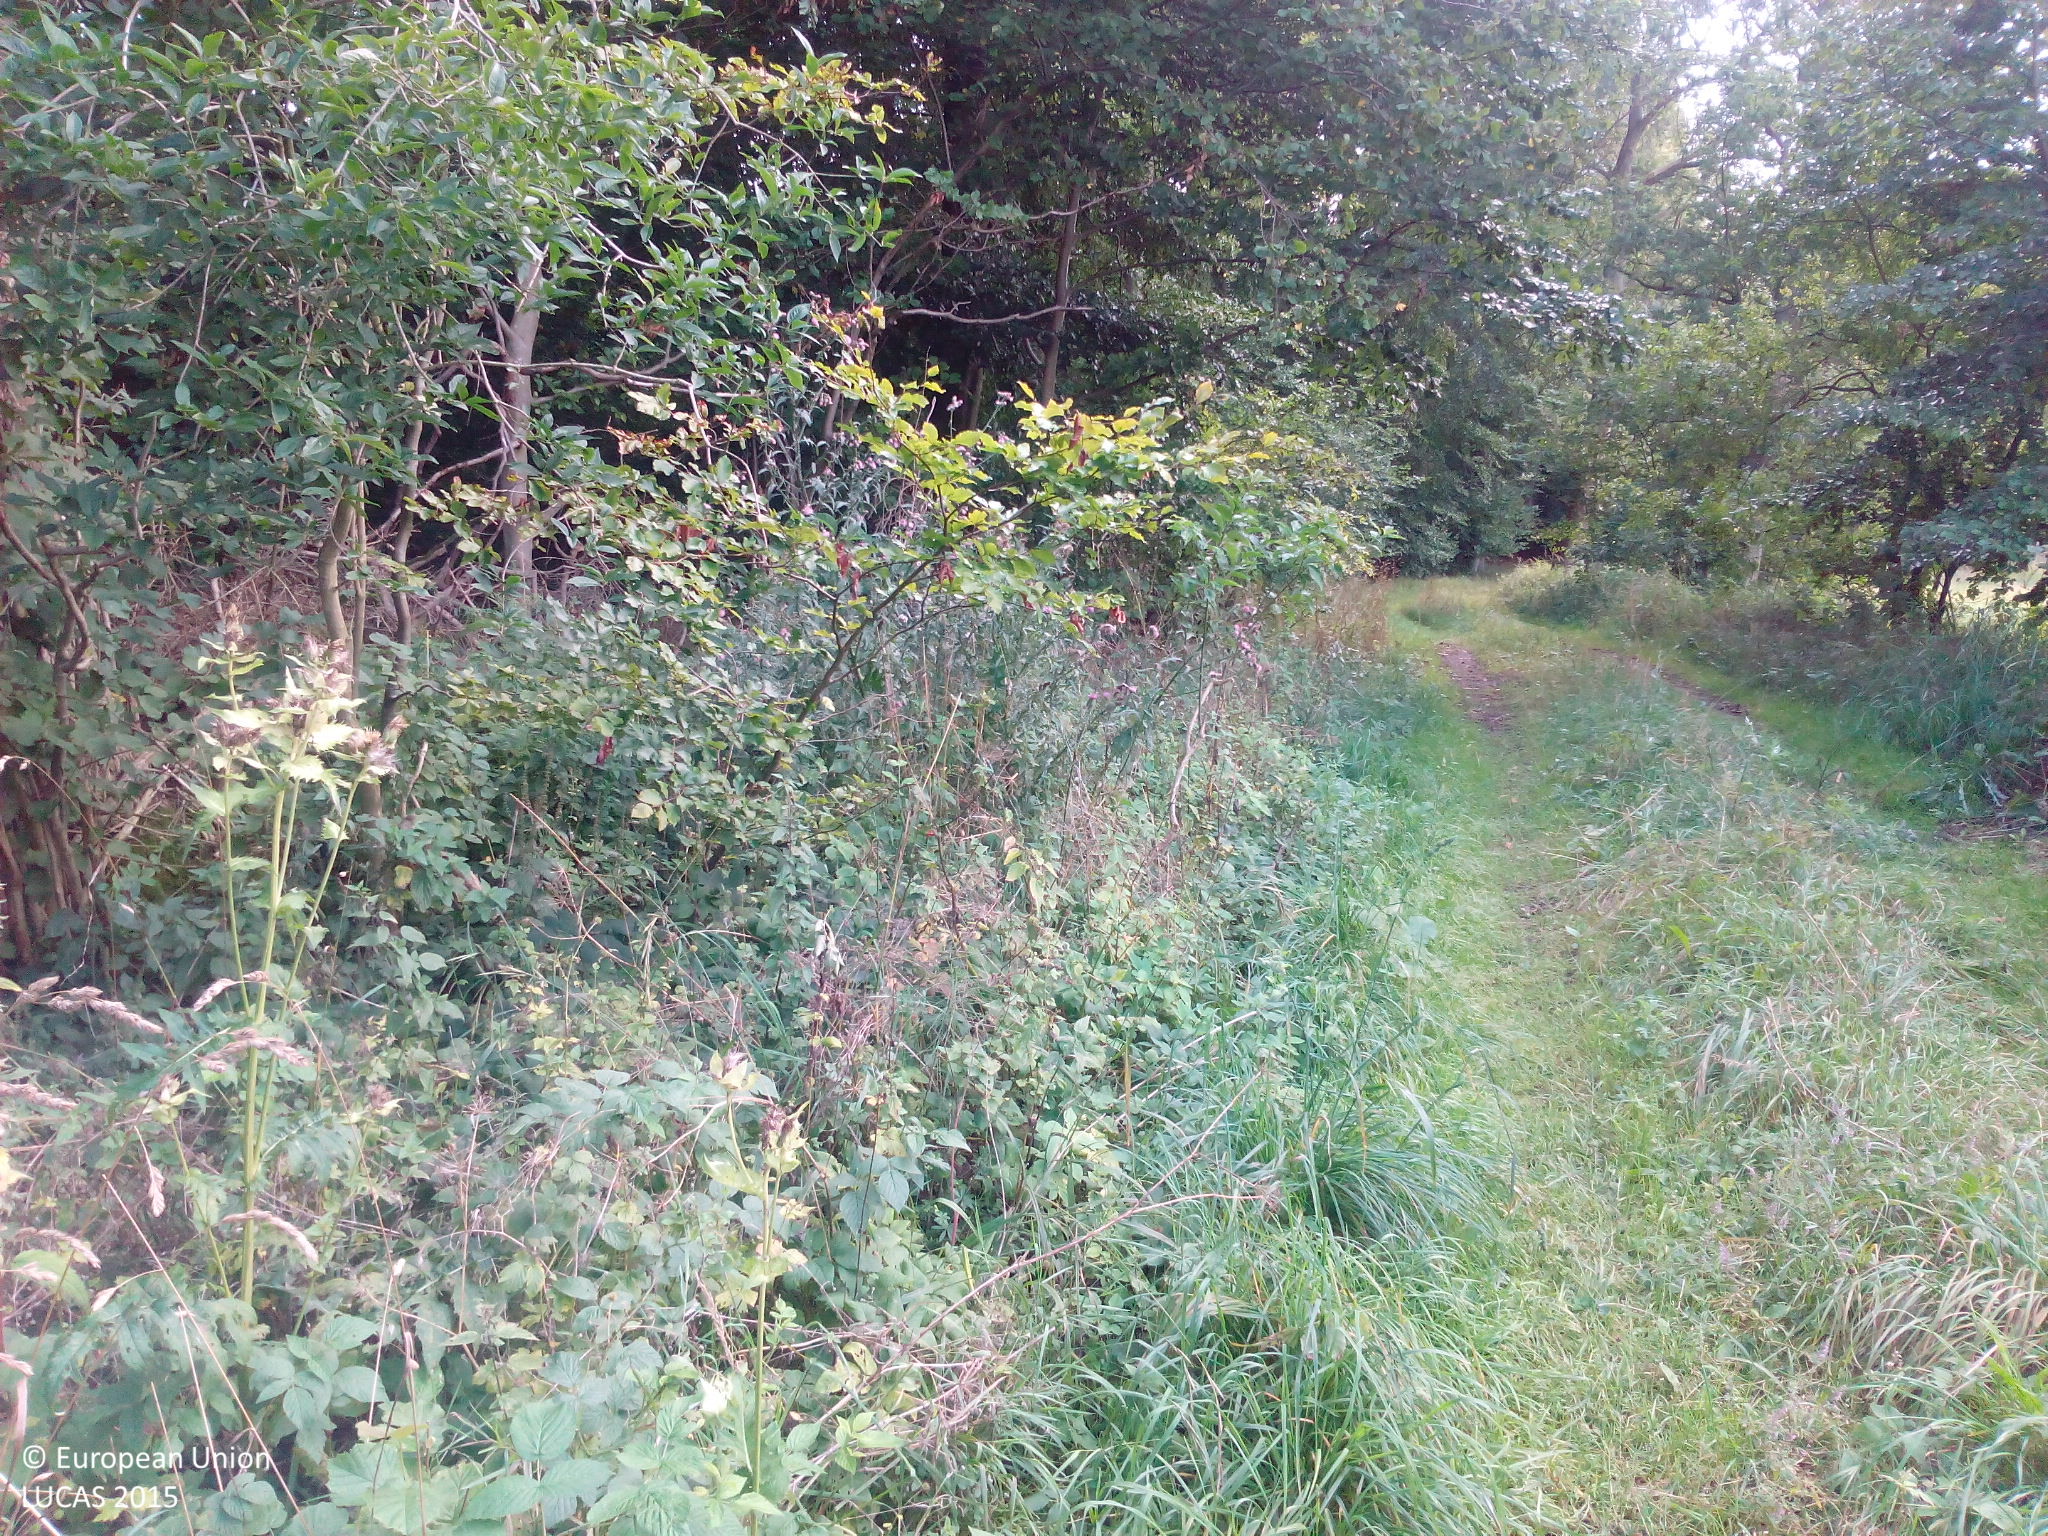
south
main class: Woodland
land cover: Broadleaved woodland
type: mesophytic deciduous forest
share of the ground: 50 - 75 %
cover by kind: broadleaved forest trees 50 %, shrubs 40 %, herbaceous plants 10 %
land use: Forestry
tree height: > 5 m
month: August
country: DE
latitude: 54.0751
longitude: 12.6125
